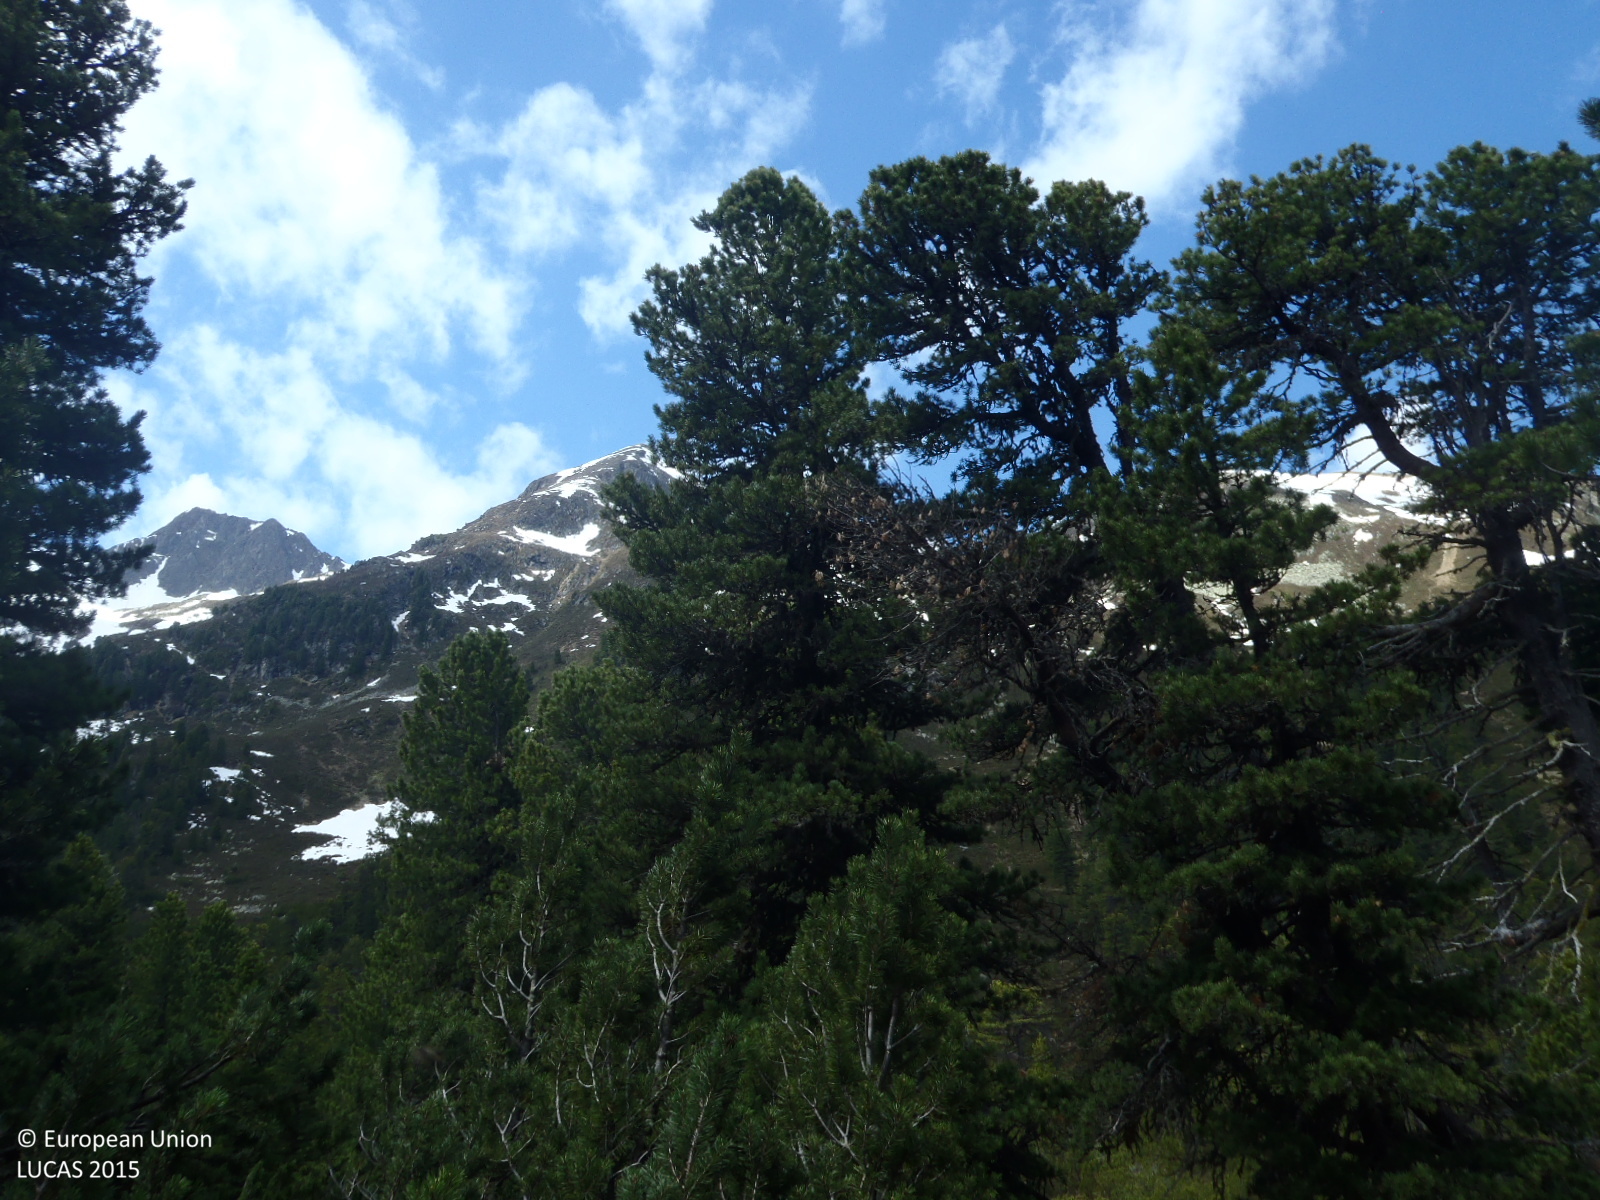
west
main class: Woodland
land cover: Other coniferous woodland
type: alpine coniferous forest
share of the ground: > 75 %
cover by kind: coniferous forest trees 75 %, shrubs 20 %, herbaceous plants 5 %
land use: Semi-natural and natural areas not in use
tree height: > 5 m
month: June
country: AT
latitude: 47.2111
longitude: 10.9893
